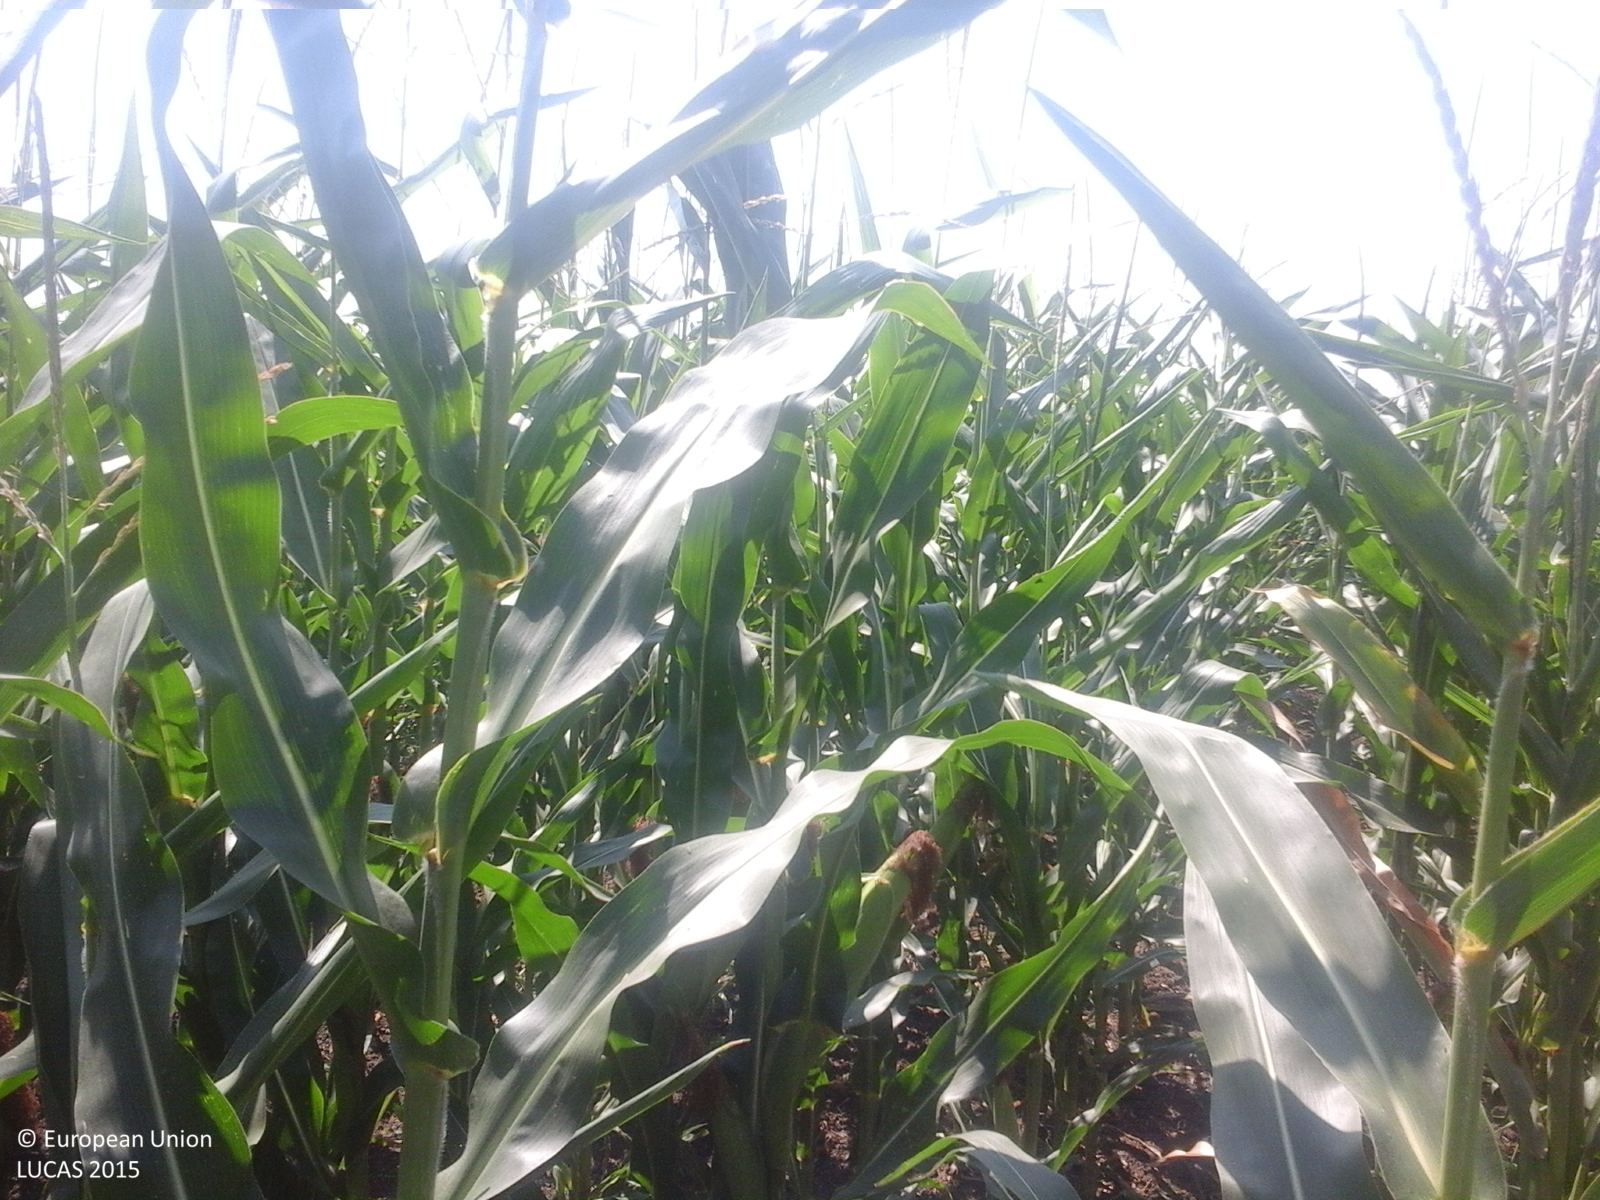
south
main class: Cropland
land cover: Maize
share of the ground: > 75 %
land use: Agriculture (excluding fallow land and kitchen gardens)
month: July
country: RO
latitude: 44.9101
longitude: 27.5130
